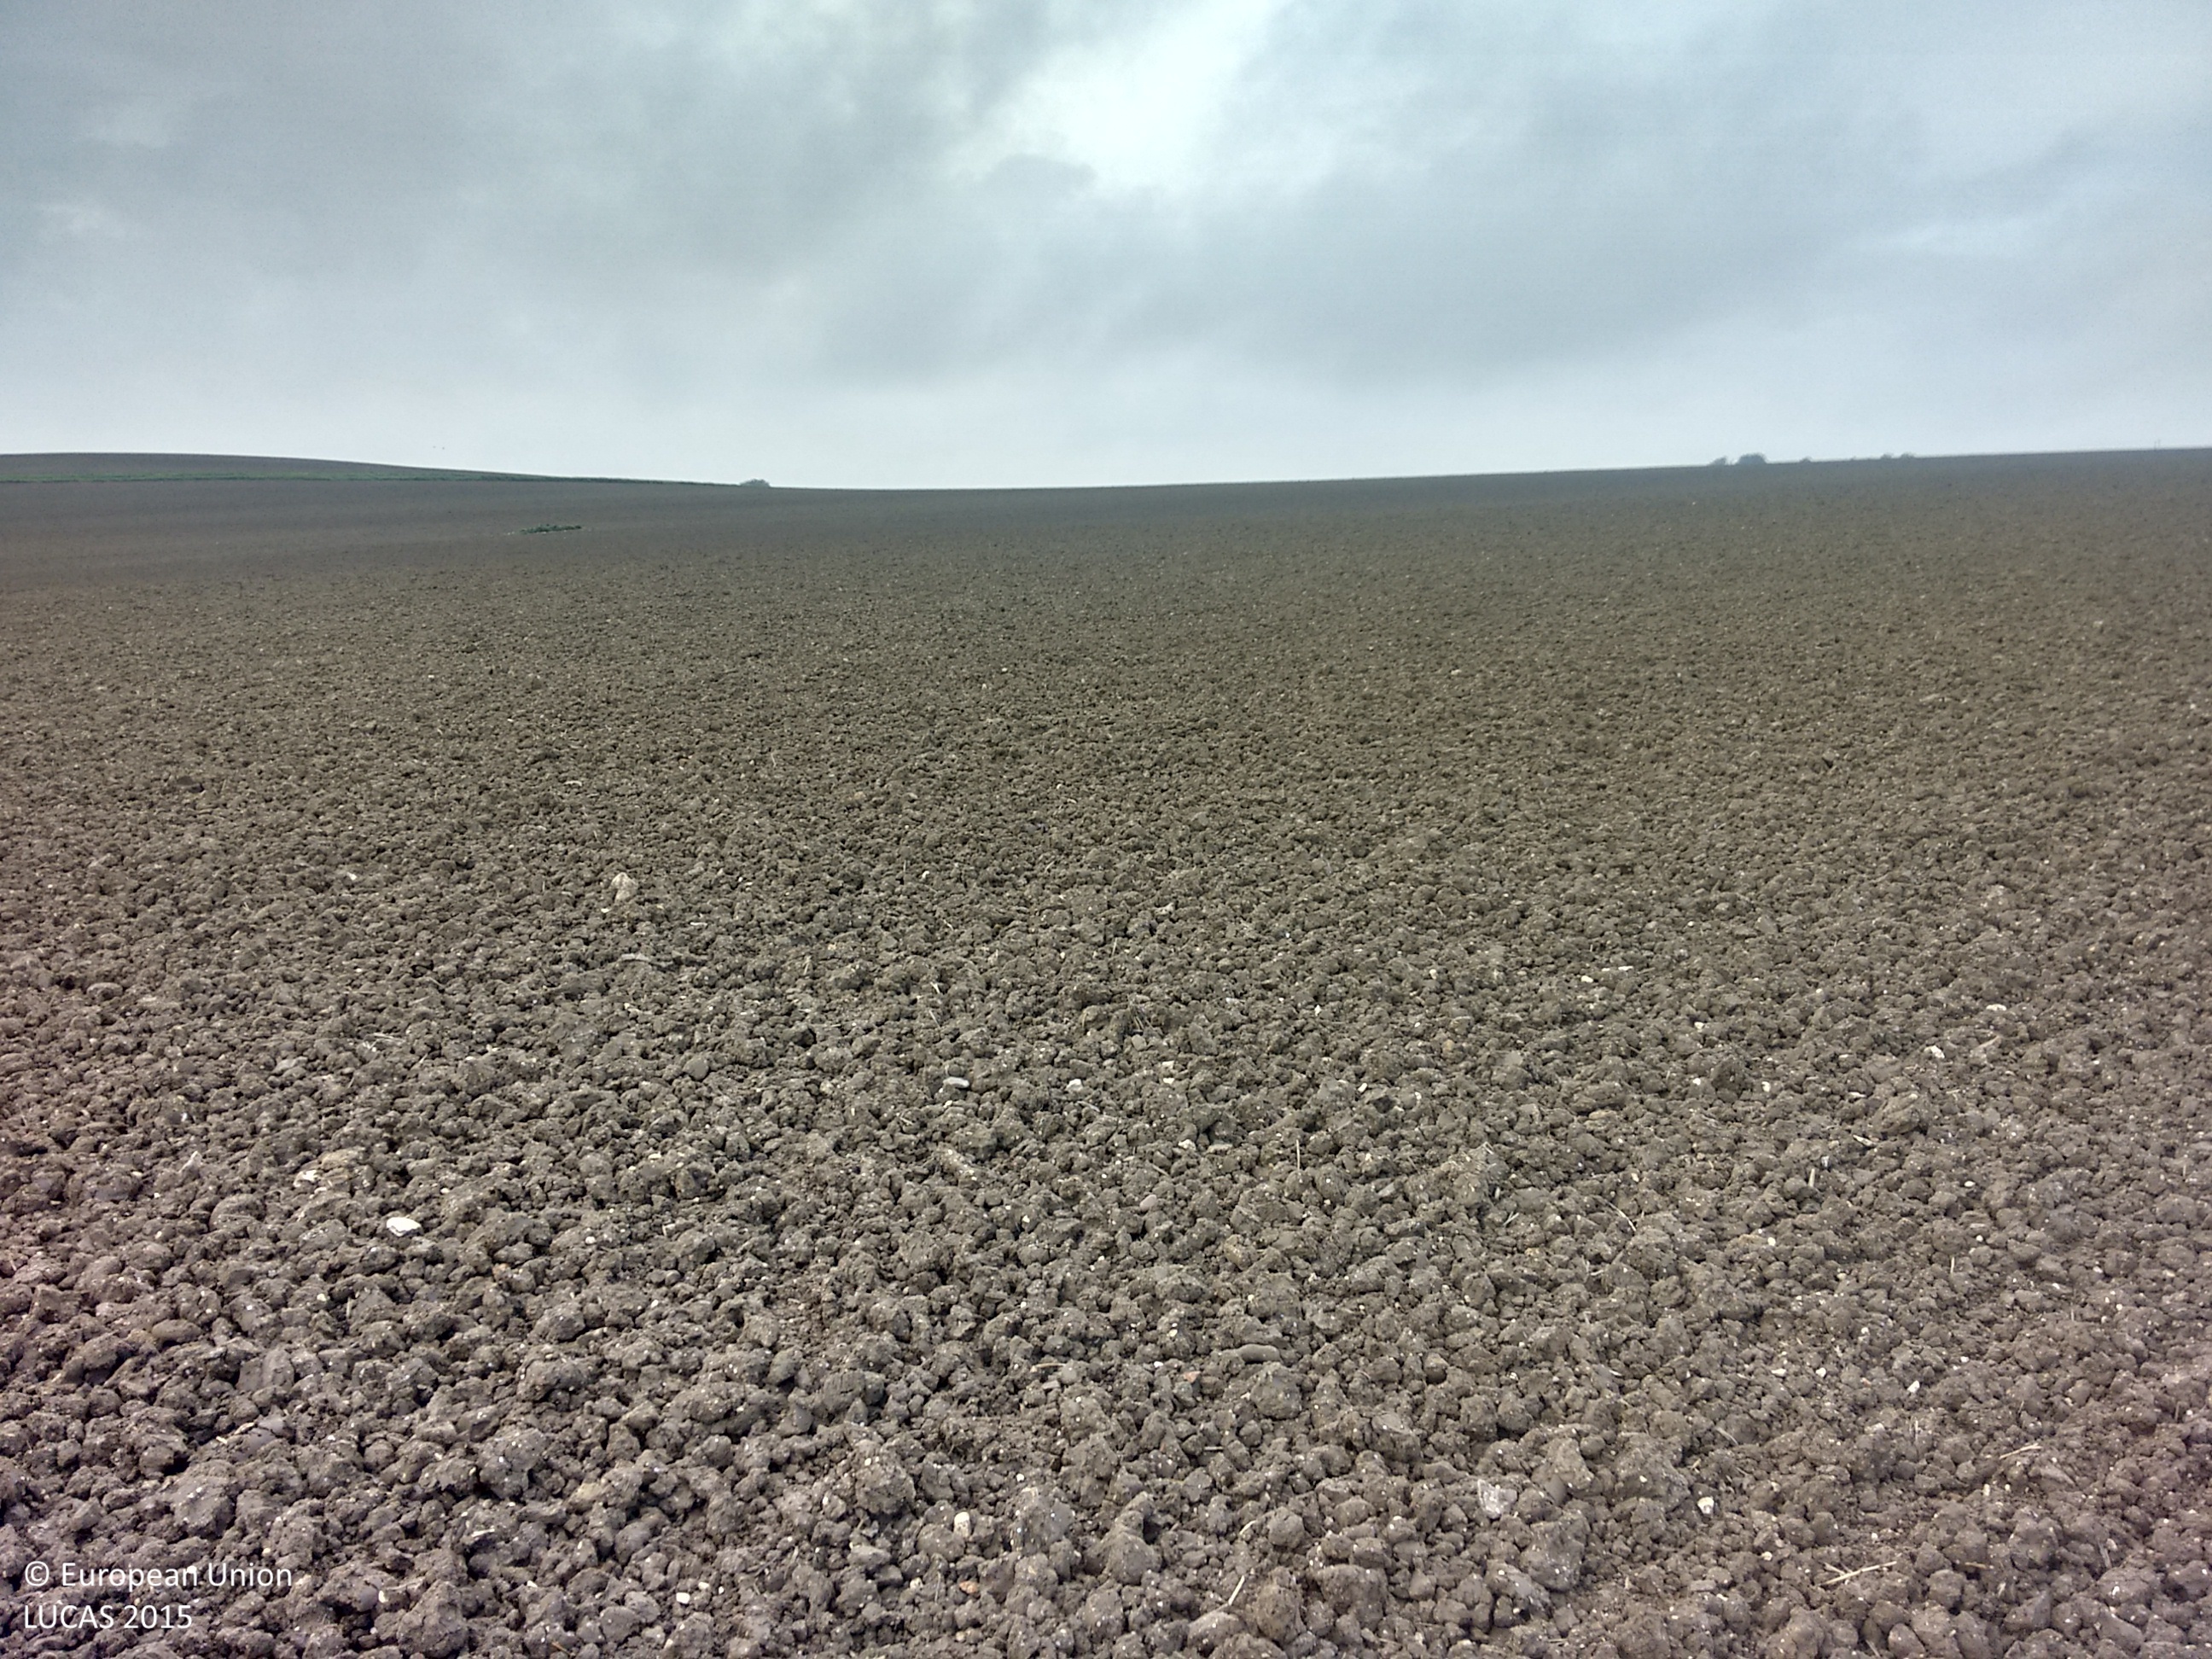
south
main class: Cropland
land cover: Common wheat
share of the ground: < 10 %
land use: Agriculture (excluding fallow land and kitchen gardens)
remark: Harvested field
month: October
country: GB
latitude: 52.0698
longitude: 0.2981
